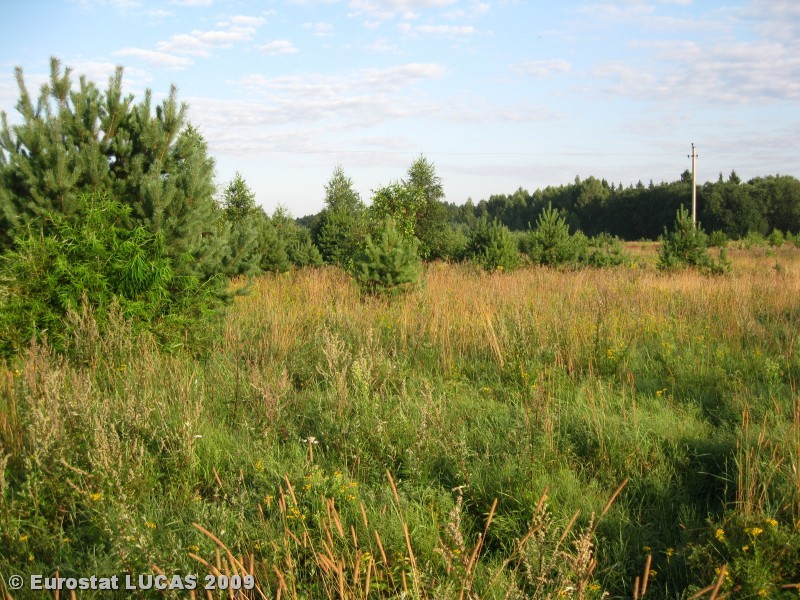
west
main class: Grassland
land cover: Grassland with sparse tree/shrub cover
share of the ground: > 75 %
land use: Agriculture (excluding fallow land and kitchen gardens)
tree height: > 5 m
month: August
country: LT
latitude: 54.9911
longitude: 23.5384
